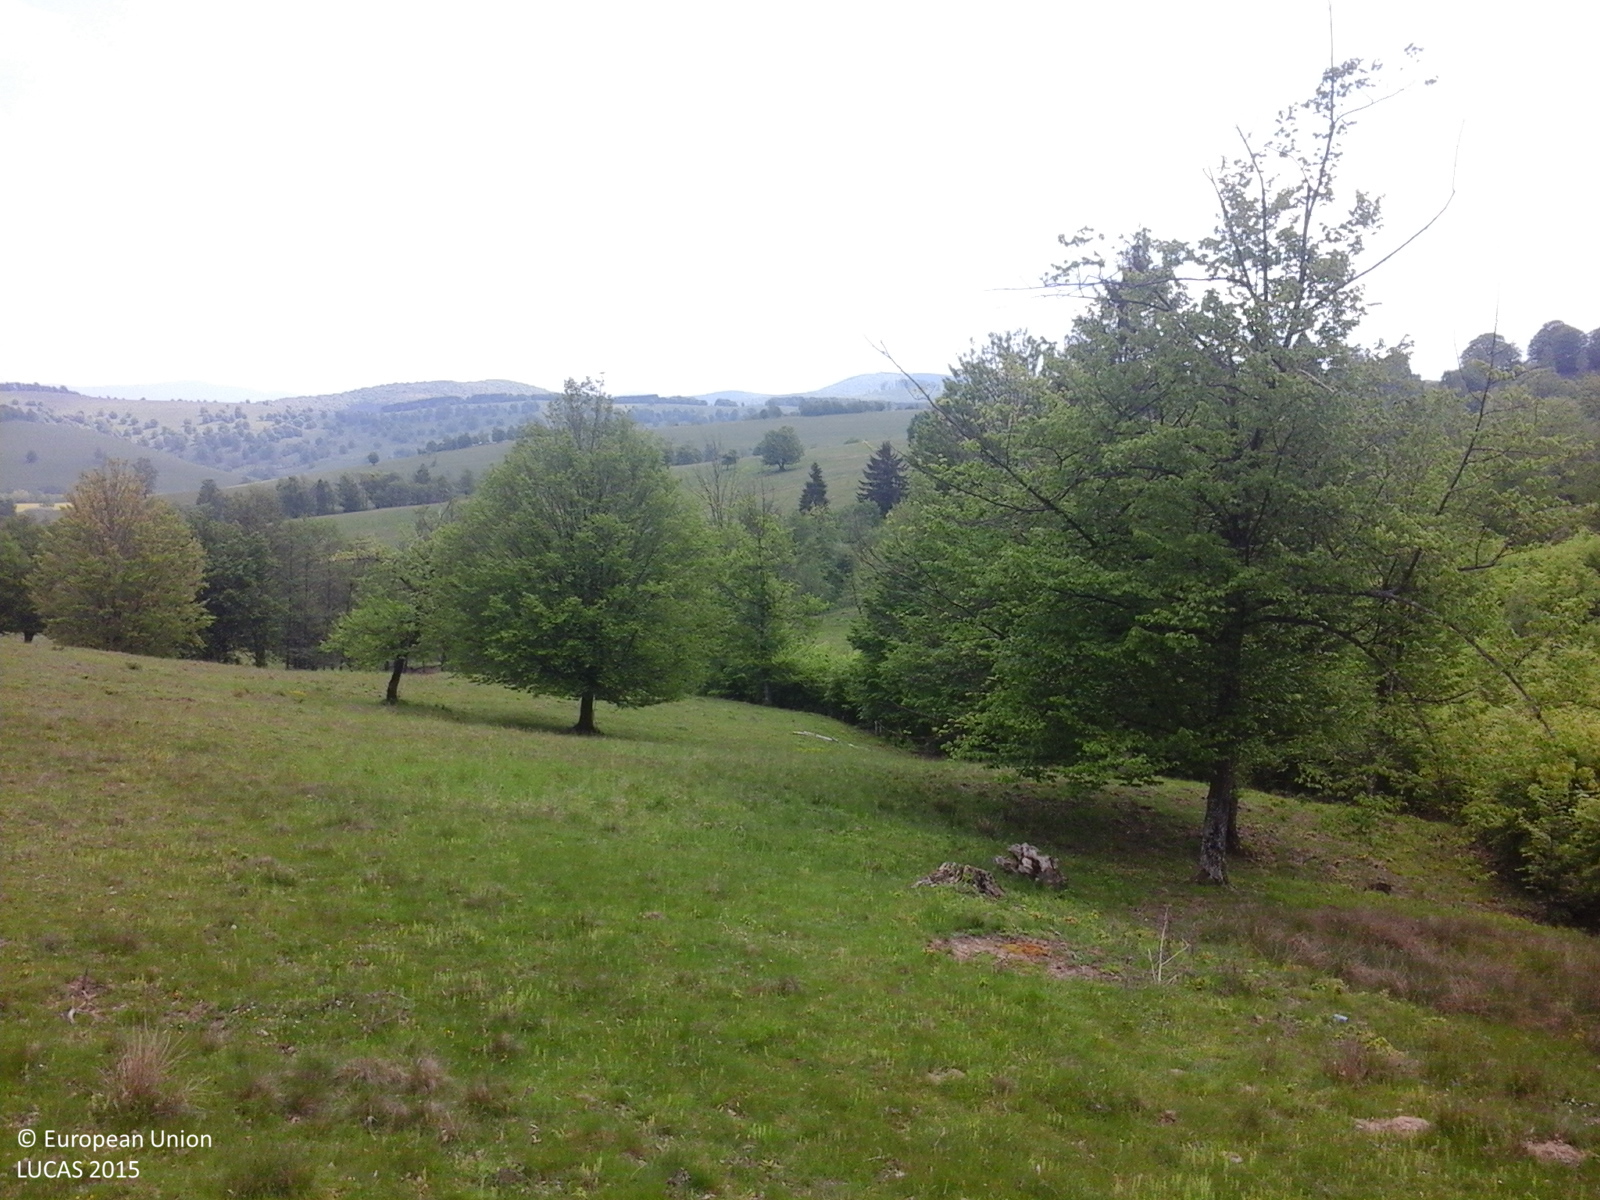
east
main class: Grassland
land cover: Grassland with sparse tree/shrub cover
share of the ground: > 75 %
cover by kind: herbaceous plants 85 %, shrubs 10 %, broadleaved forest trees 5 %
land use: Agriculture (excluding fallow land and kitchen gardens)
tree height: > 5 m
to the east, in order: Grassland with sparse tree/shrub cover; Ditches and canals; Broadleaved woodland; Grassland with sparse tree/shrub cover; Tracks; Grassland with sparse tree/shrub cover
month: May
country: RO
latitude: 45.7403
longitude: 26.0137
